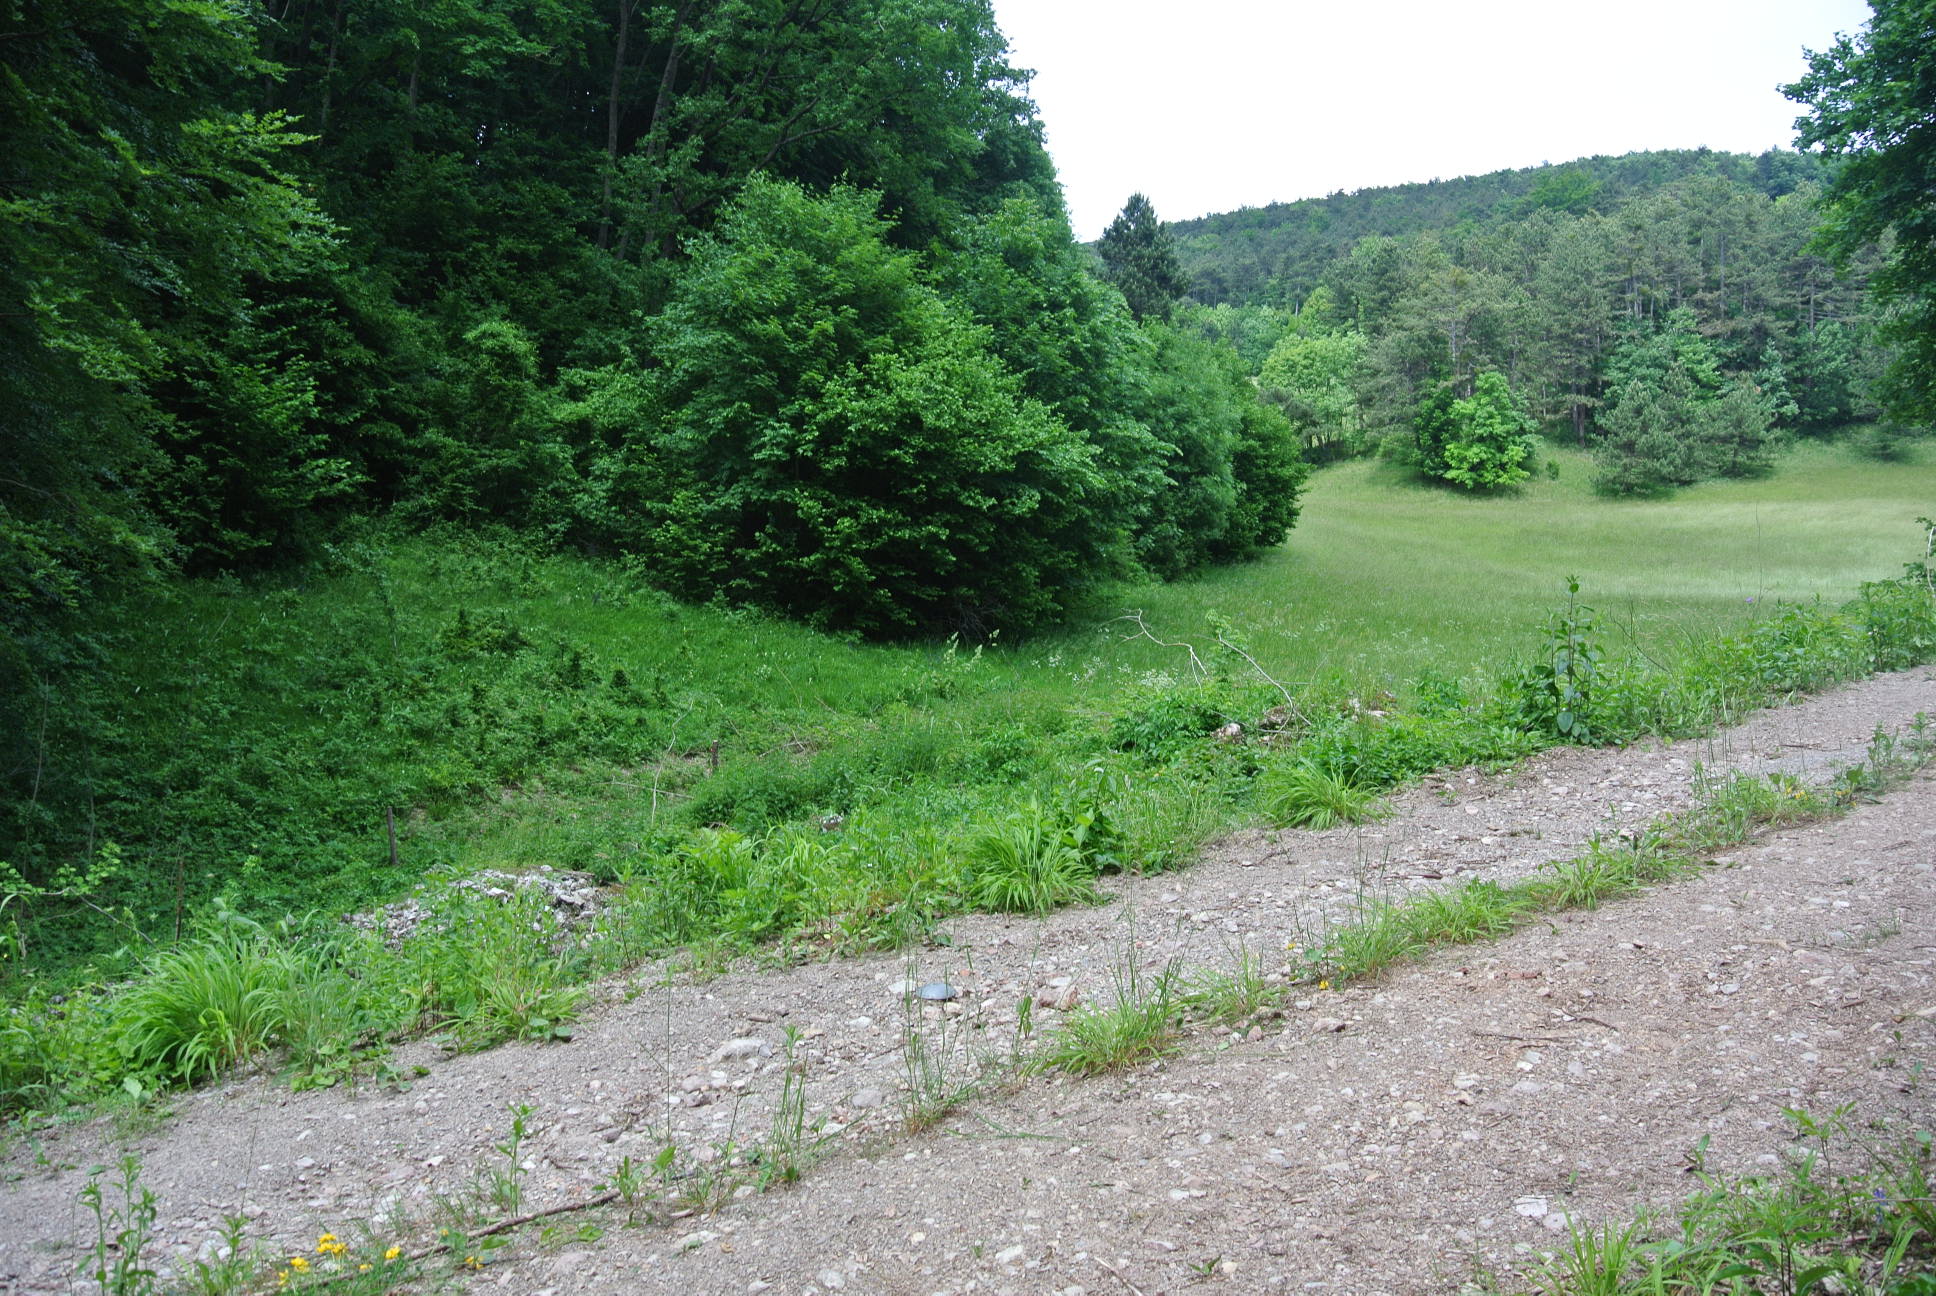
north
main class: Grassland
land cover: Spontaneously vegetated surfaces
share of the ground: > 75 %
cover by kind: herbaceous plants 95 %, shrubs 5 %
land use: Forestry
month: June
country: AT
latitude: 48.0004
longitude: 16.1019
